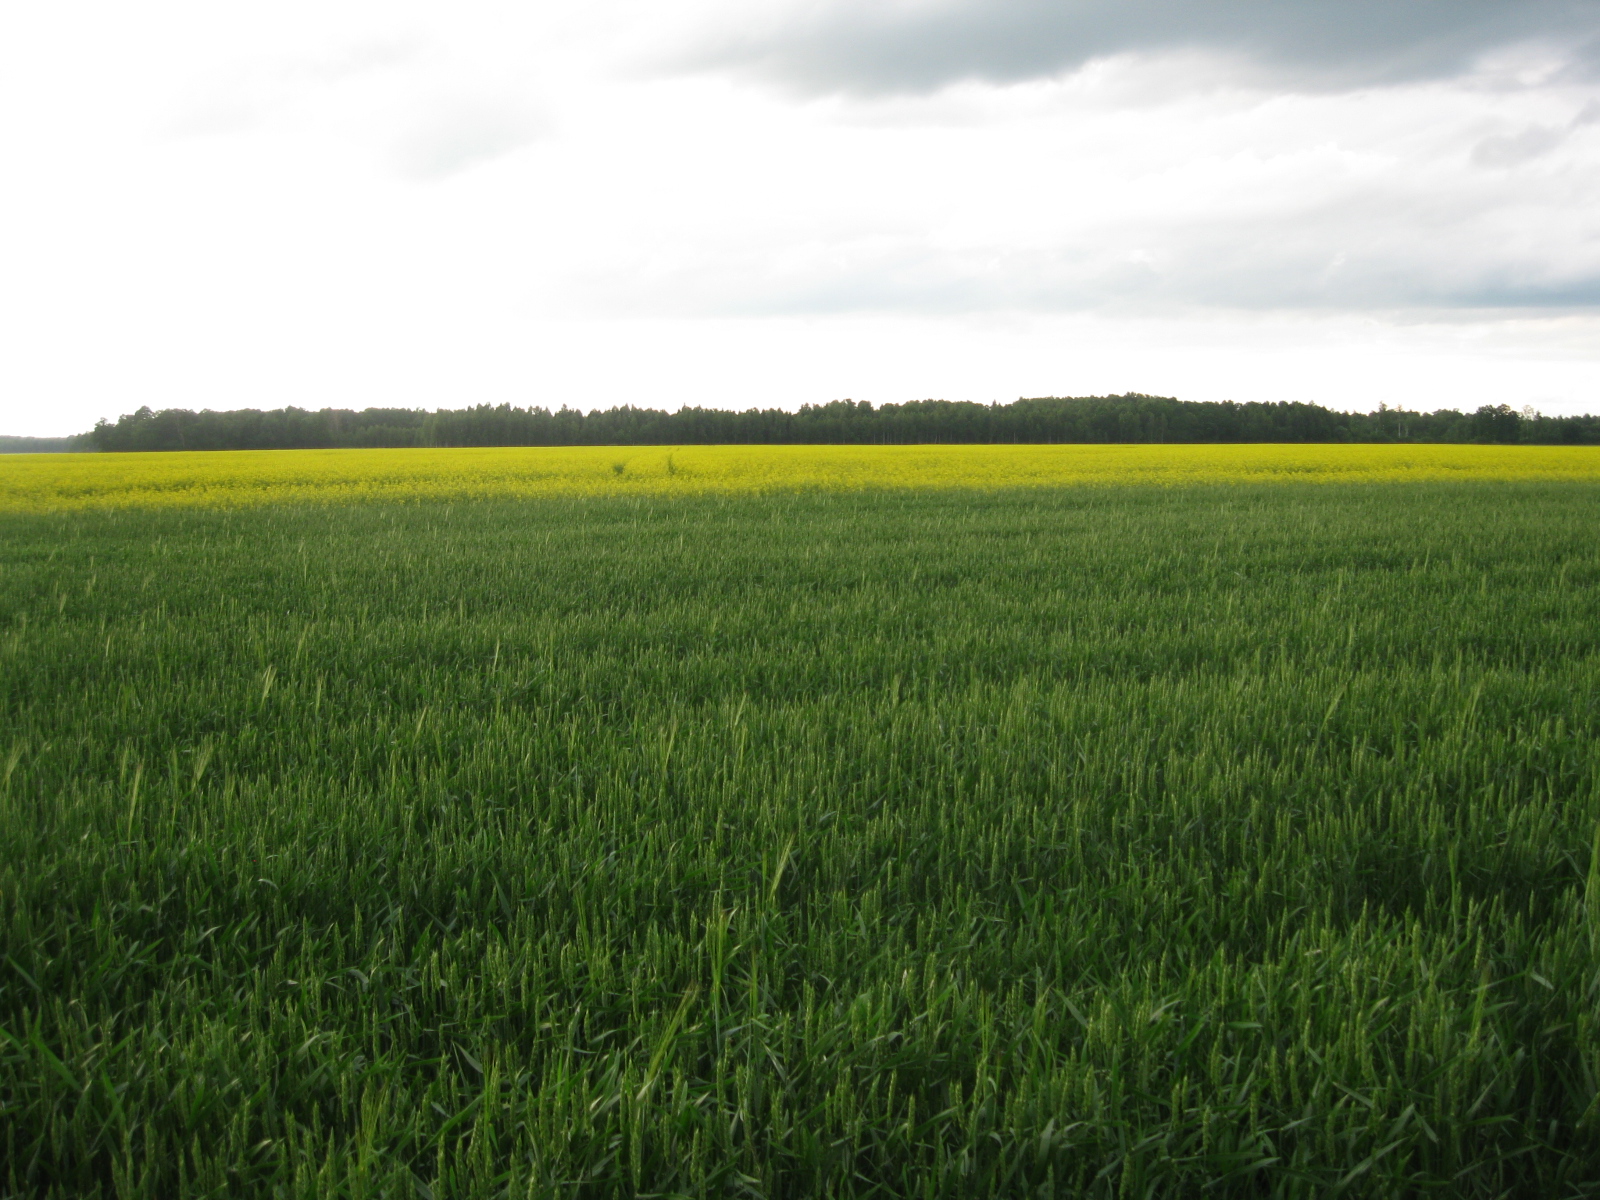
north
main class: Cropland
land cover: Common wheat
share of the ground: > 75 %
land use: Agriculture (excluding fallow land and kitchen gardens)
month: June
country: LT
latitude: 55.4671
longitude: 24.1866
